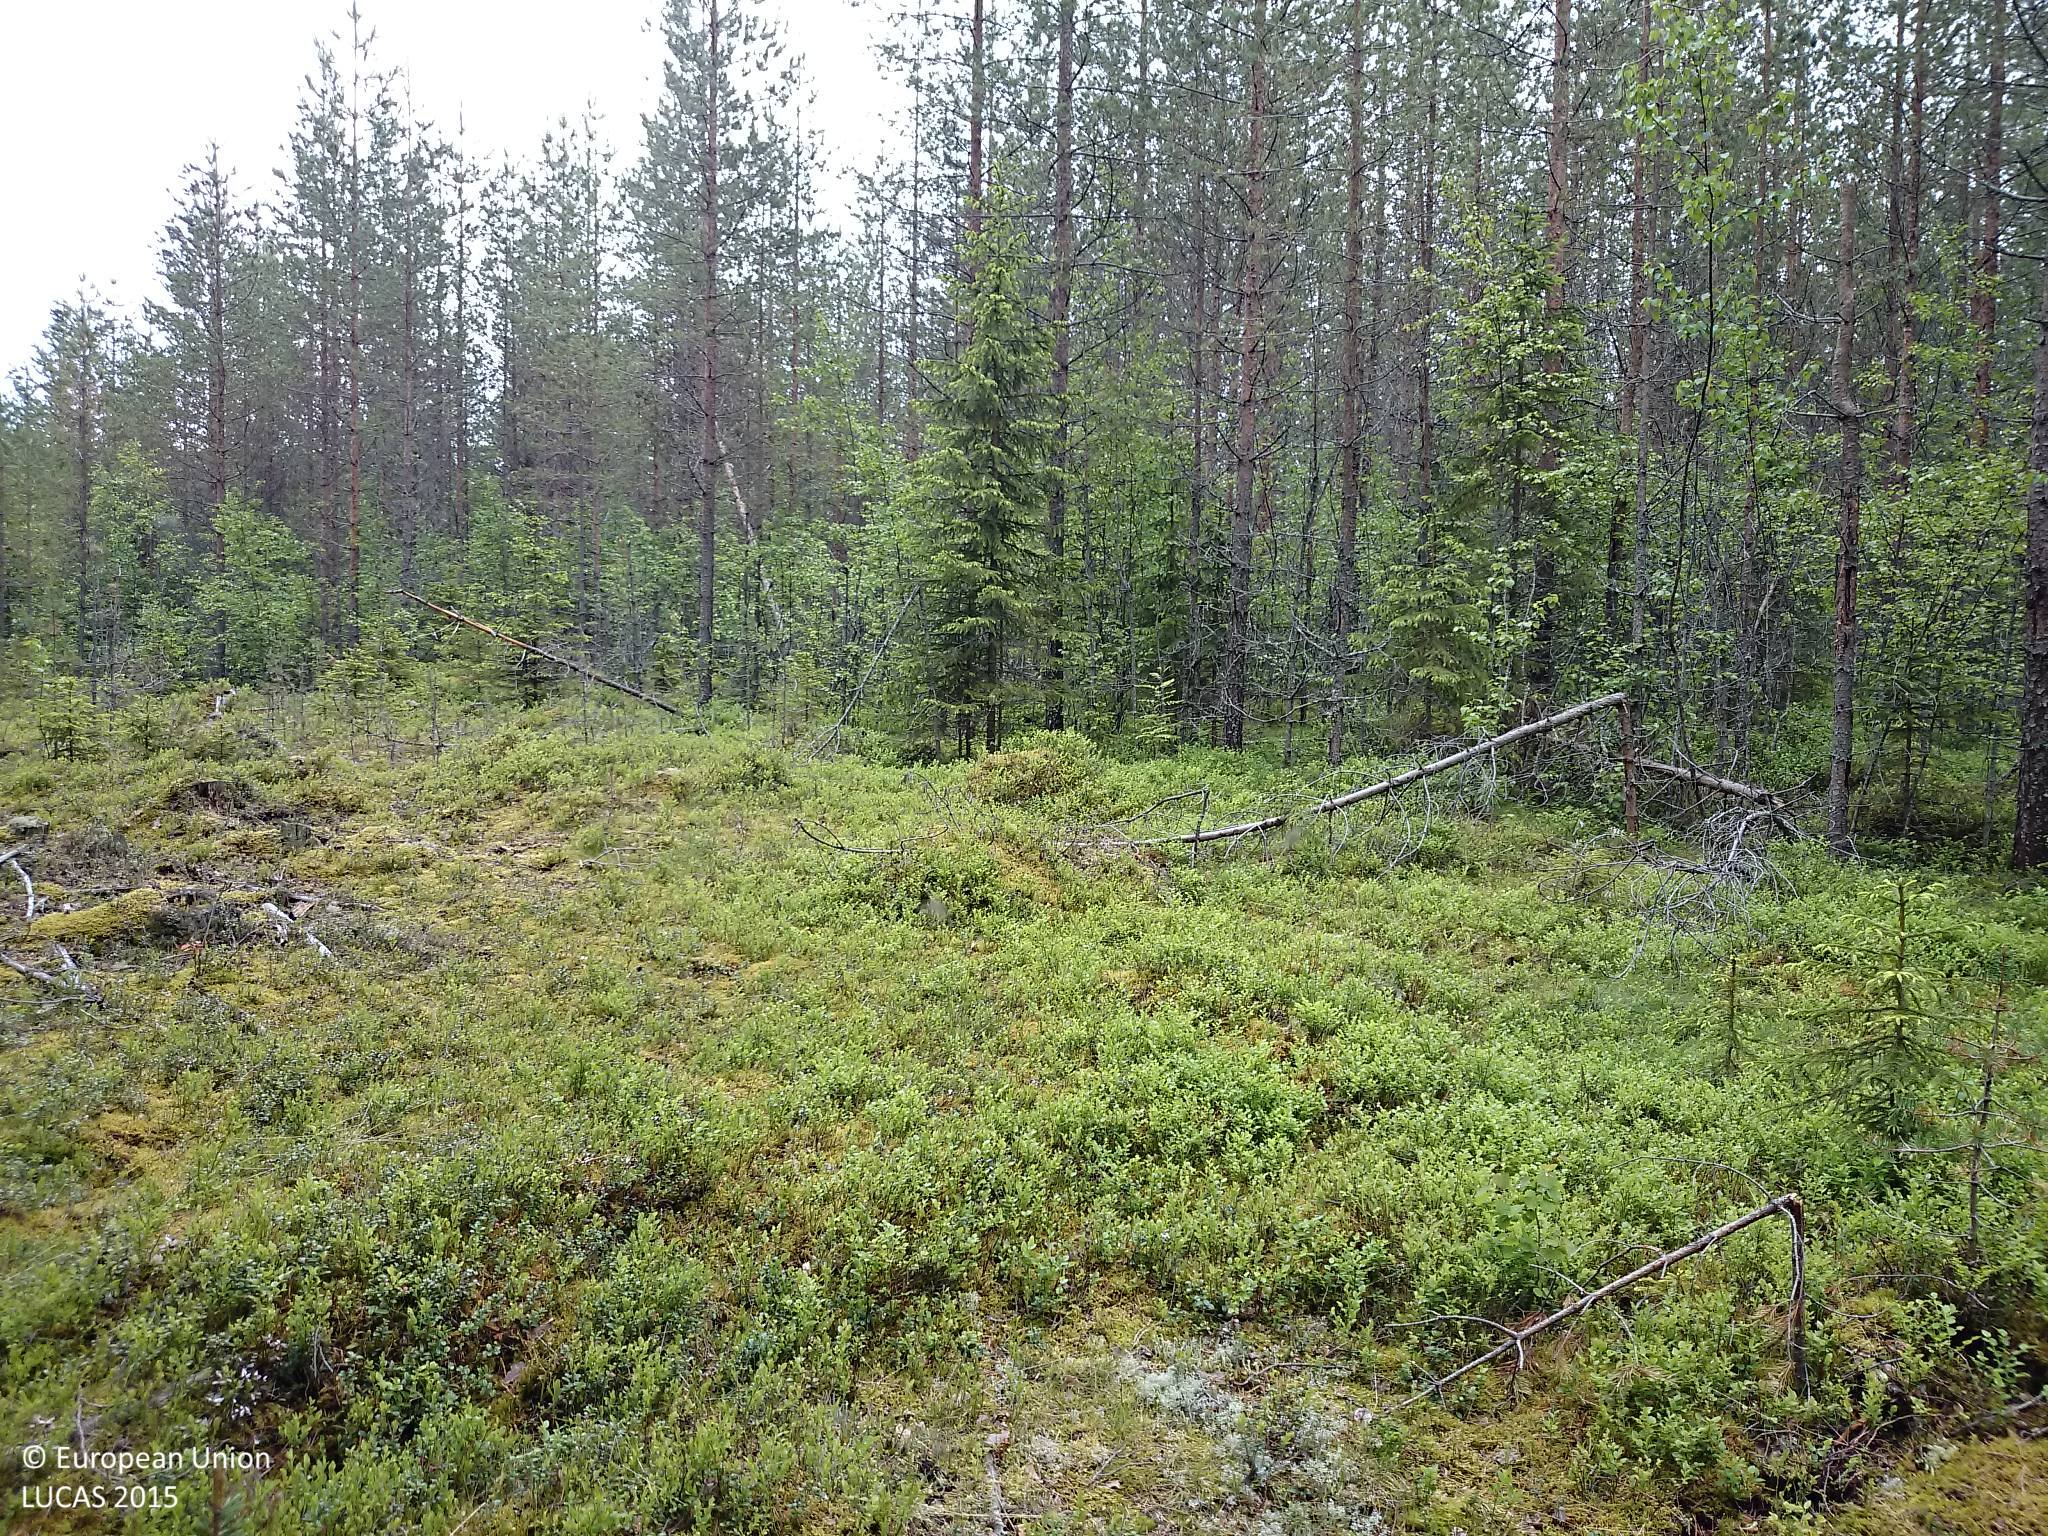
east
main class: Woodland
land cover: Pine dominated mixed woodland
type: boreal forest
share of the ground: > 75 %
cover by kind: coniferous forest trees 60 %, broadleaved forest trees 20 %, shrubs 20 %
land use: Forestry
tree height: > 5 m
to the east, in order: Pine dominated mixed woodland; Spruce dominated mixed woodland; Rivers and streams; Spruce dominated mixed woodland; Grassland with sparse tree/shrub cover; Tracks; Grassland with sparse tree/shrub cover; Ditches and canals; Spruce dominated mixed woodland; Spruce dominated coniferous woodland
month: June
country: SE
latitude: 64.1253
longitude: 20.7237
